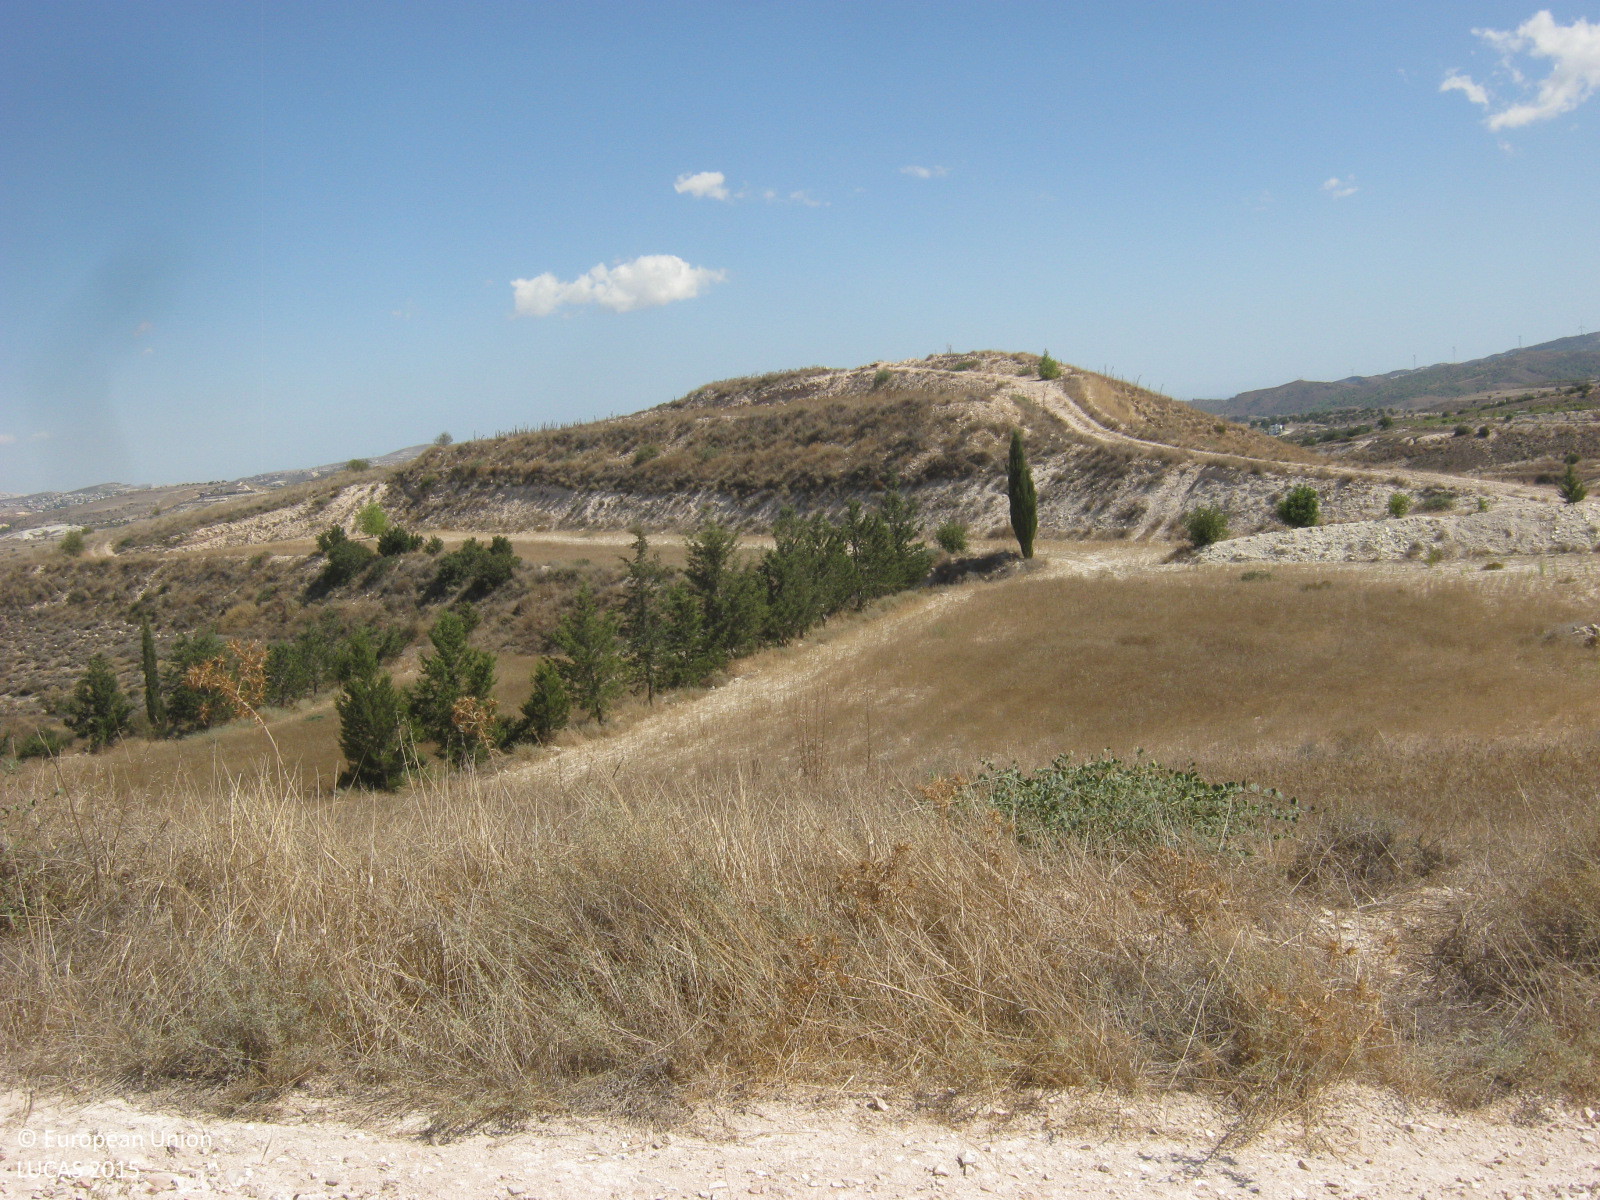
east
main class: Grassland
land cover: Grassland without tree/shrub cover
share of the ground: 25 - 50 %
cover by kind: unconsolidated bare surface 55 %, herbaceous plants 45 %
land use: Semi-natural and natural areas not in use
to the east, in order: Grassland without tree/shrub cover; Tracks; Grassland without tree/shrub cover; Shrubland without tree cover; Grassland without tree/shrub cover; Shrubland without tree cover; Tracks; Grassland without tree/shrub cover
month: April
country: CY
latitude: 34.9954
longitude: 33.3832
